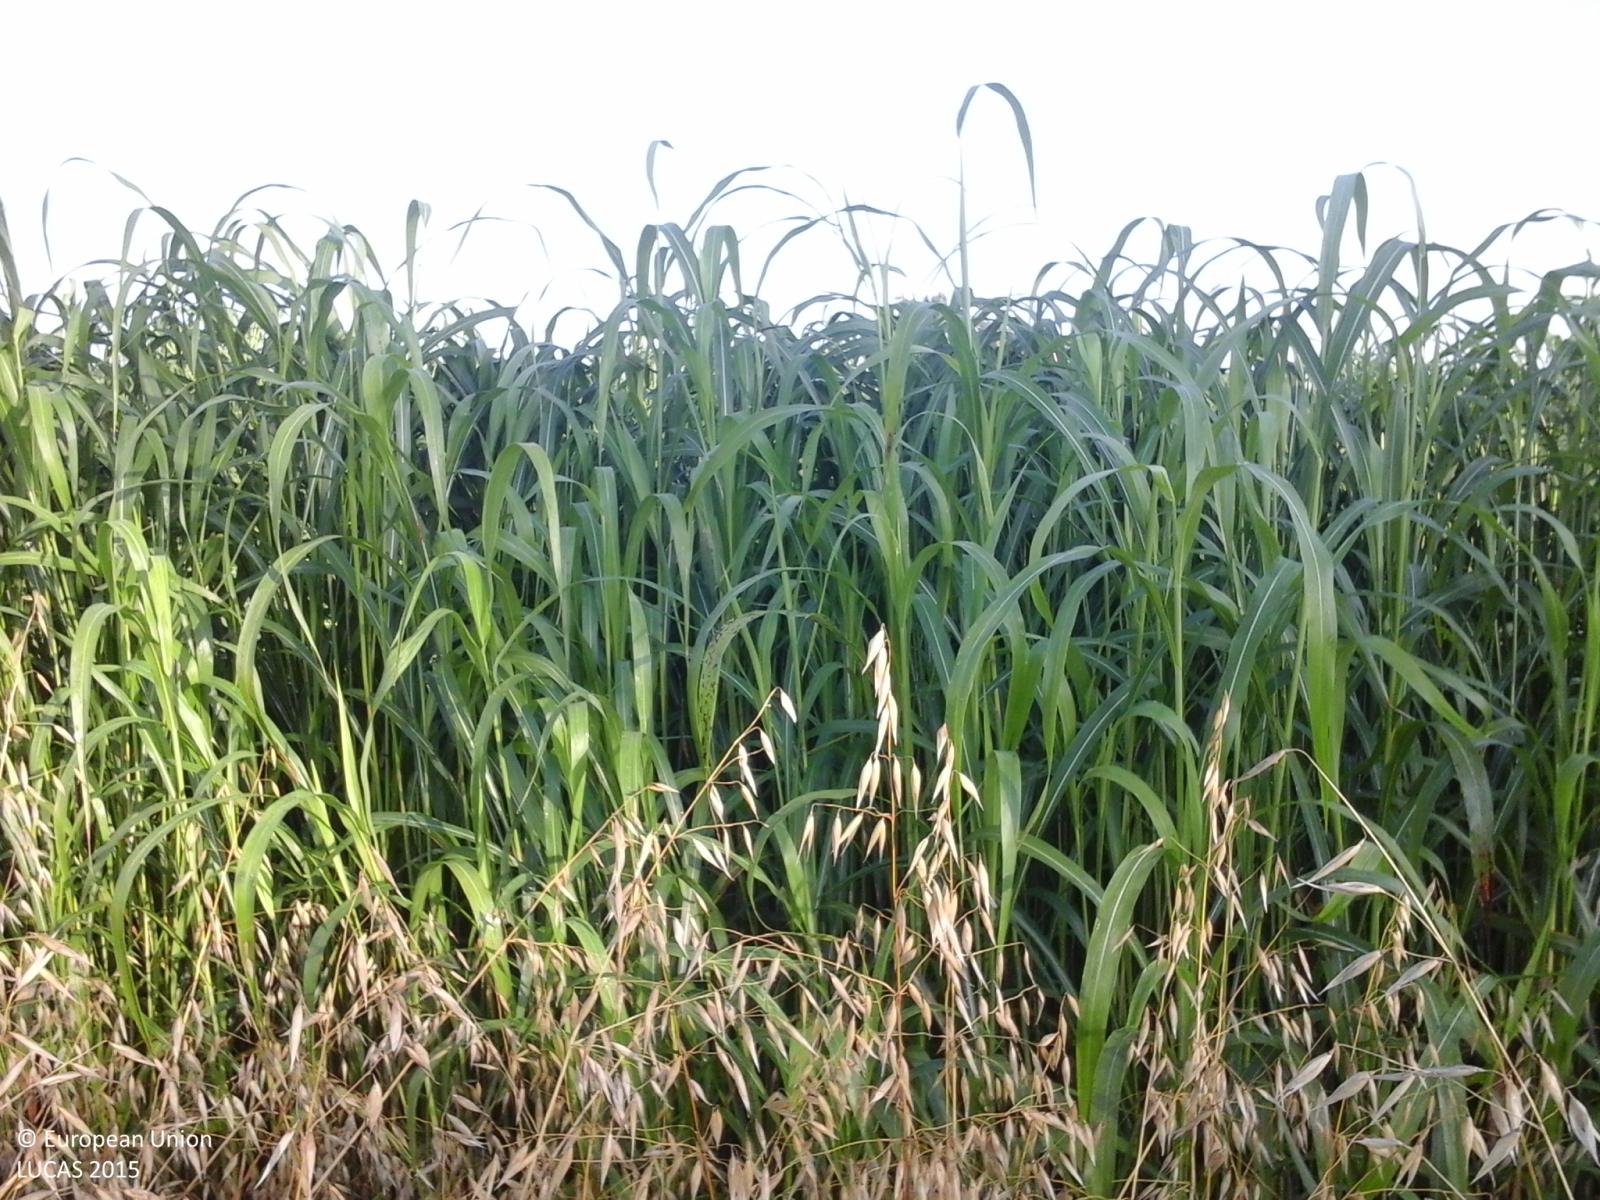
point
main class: Grassland
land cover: Spontaneously vegetated surfaces
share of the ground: > 75 %
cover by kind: herbaceous plants 100 %
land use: Agriculture (excluding fallow land and kitchen gardens)
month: June
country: IT
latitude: 44.5990
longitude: 10.9177
